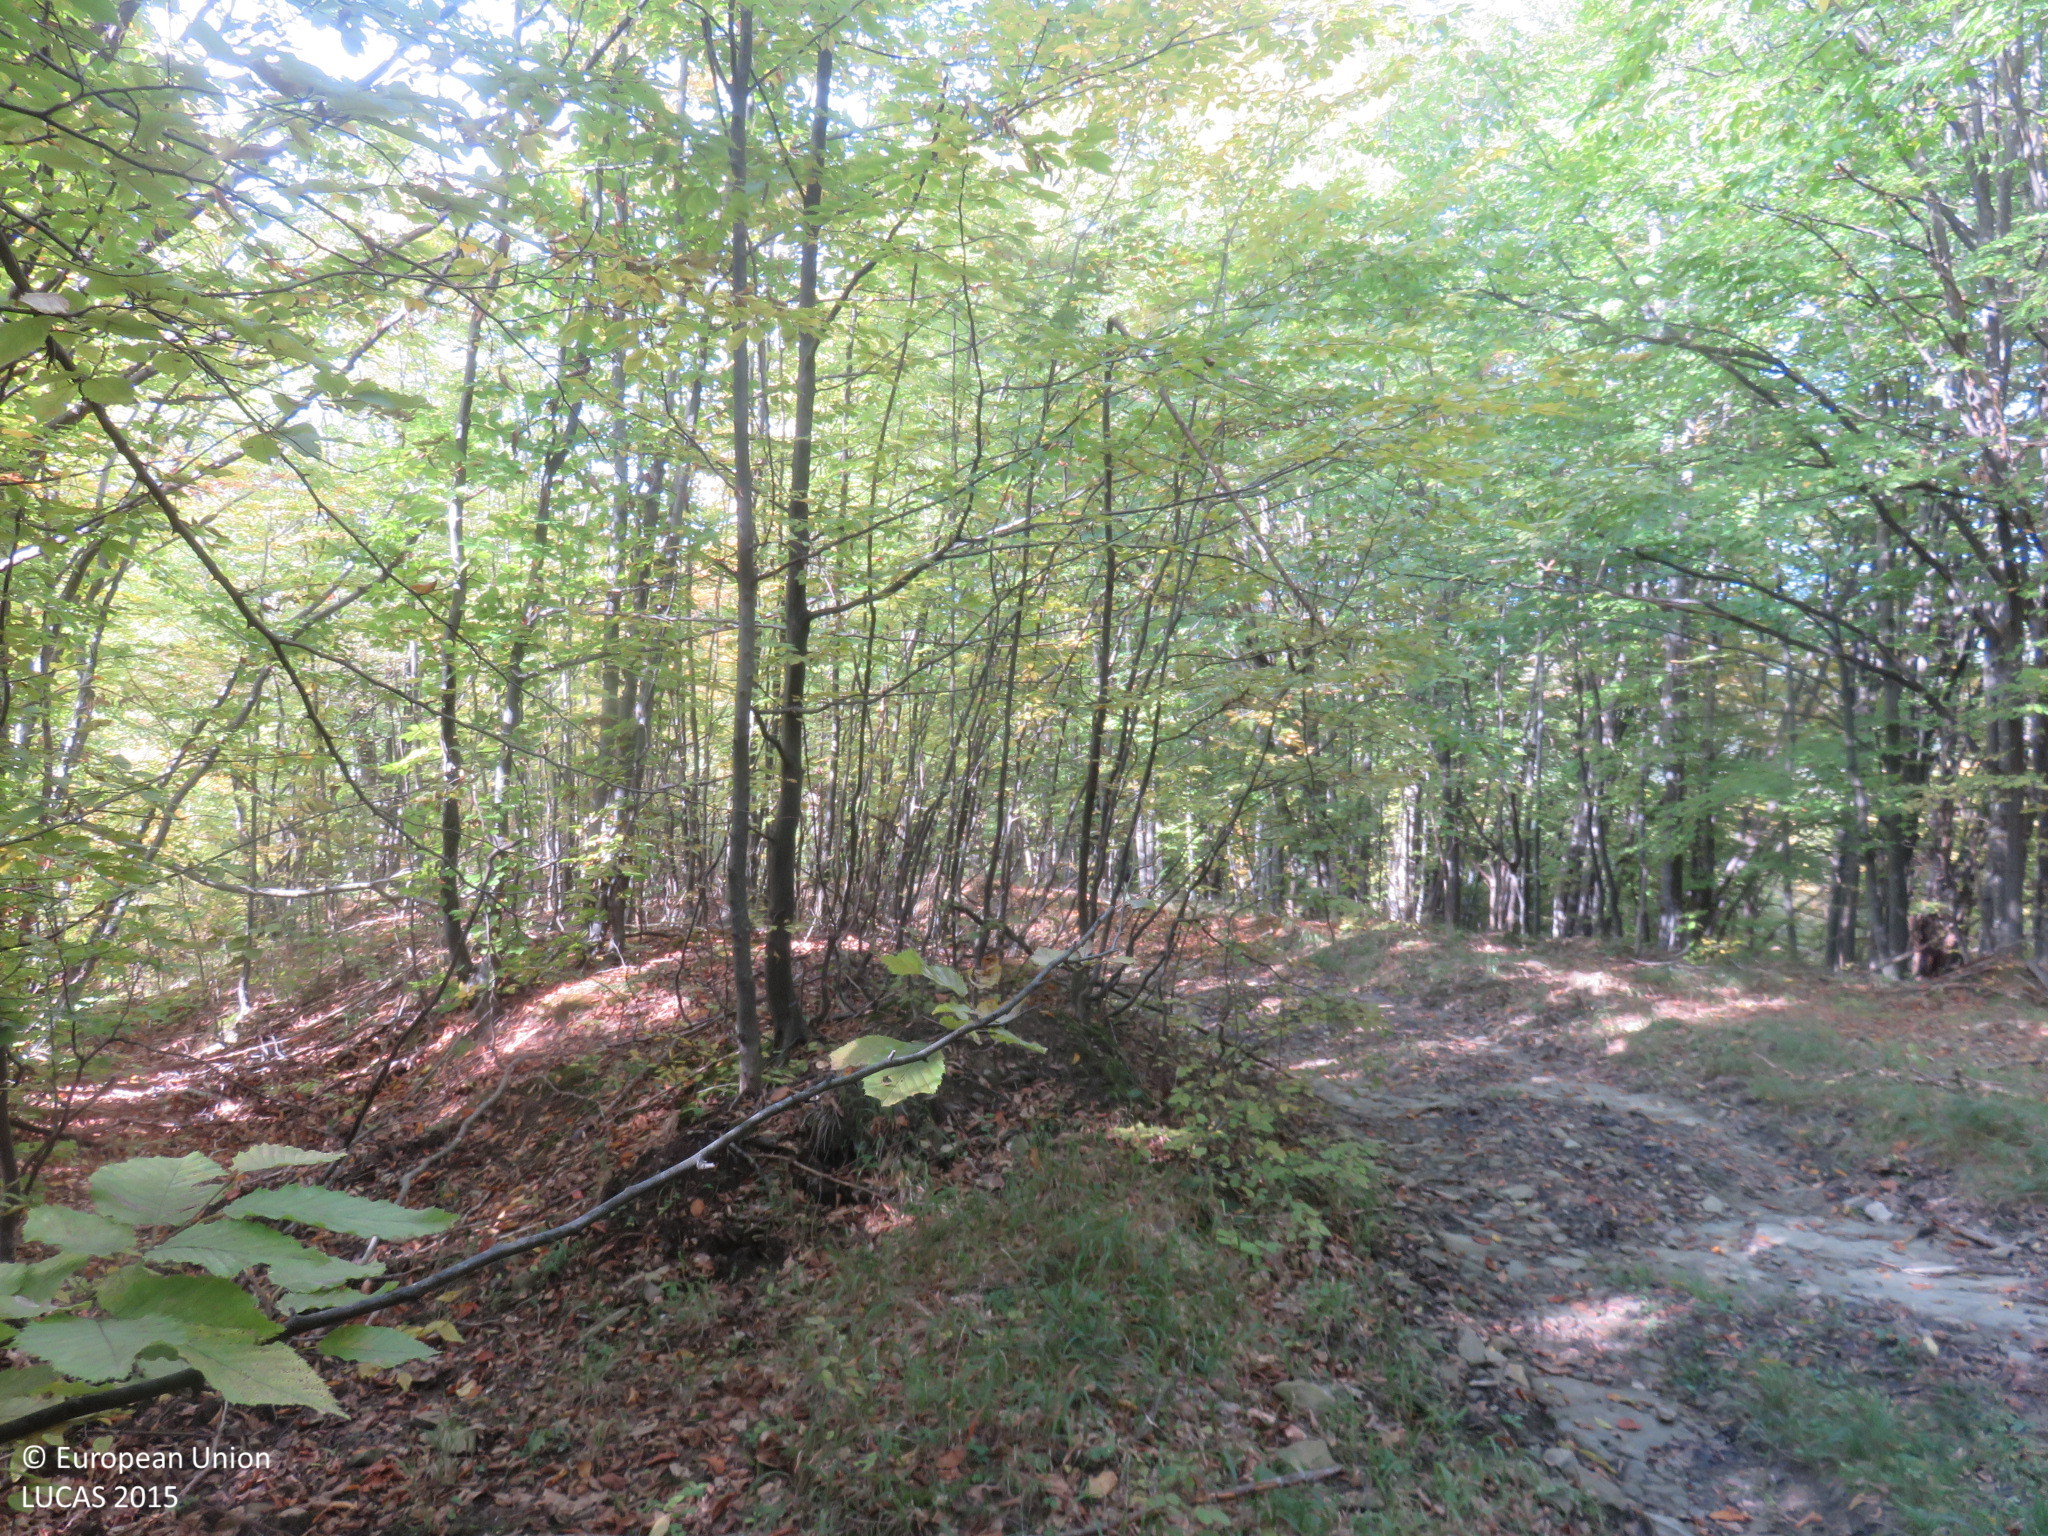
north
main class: Woodland
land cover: Broadleaved woodland
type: beech forest
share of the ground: > 75 %
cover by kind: broadleaved forest trees 95 %, shrubs 5 %
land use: Forestry
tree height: > 5 m
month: October
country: BG
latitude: 42.7855
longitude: 24.9393
